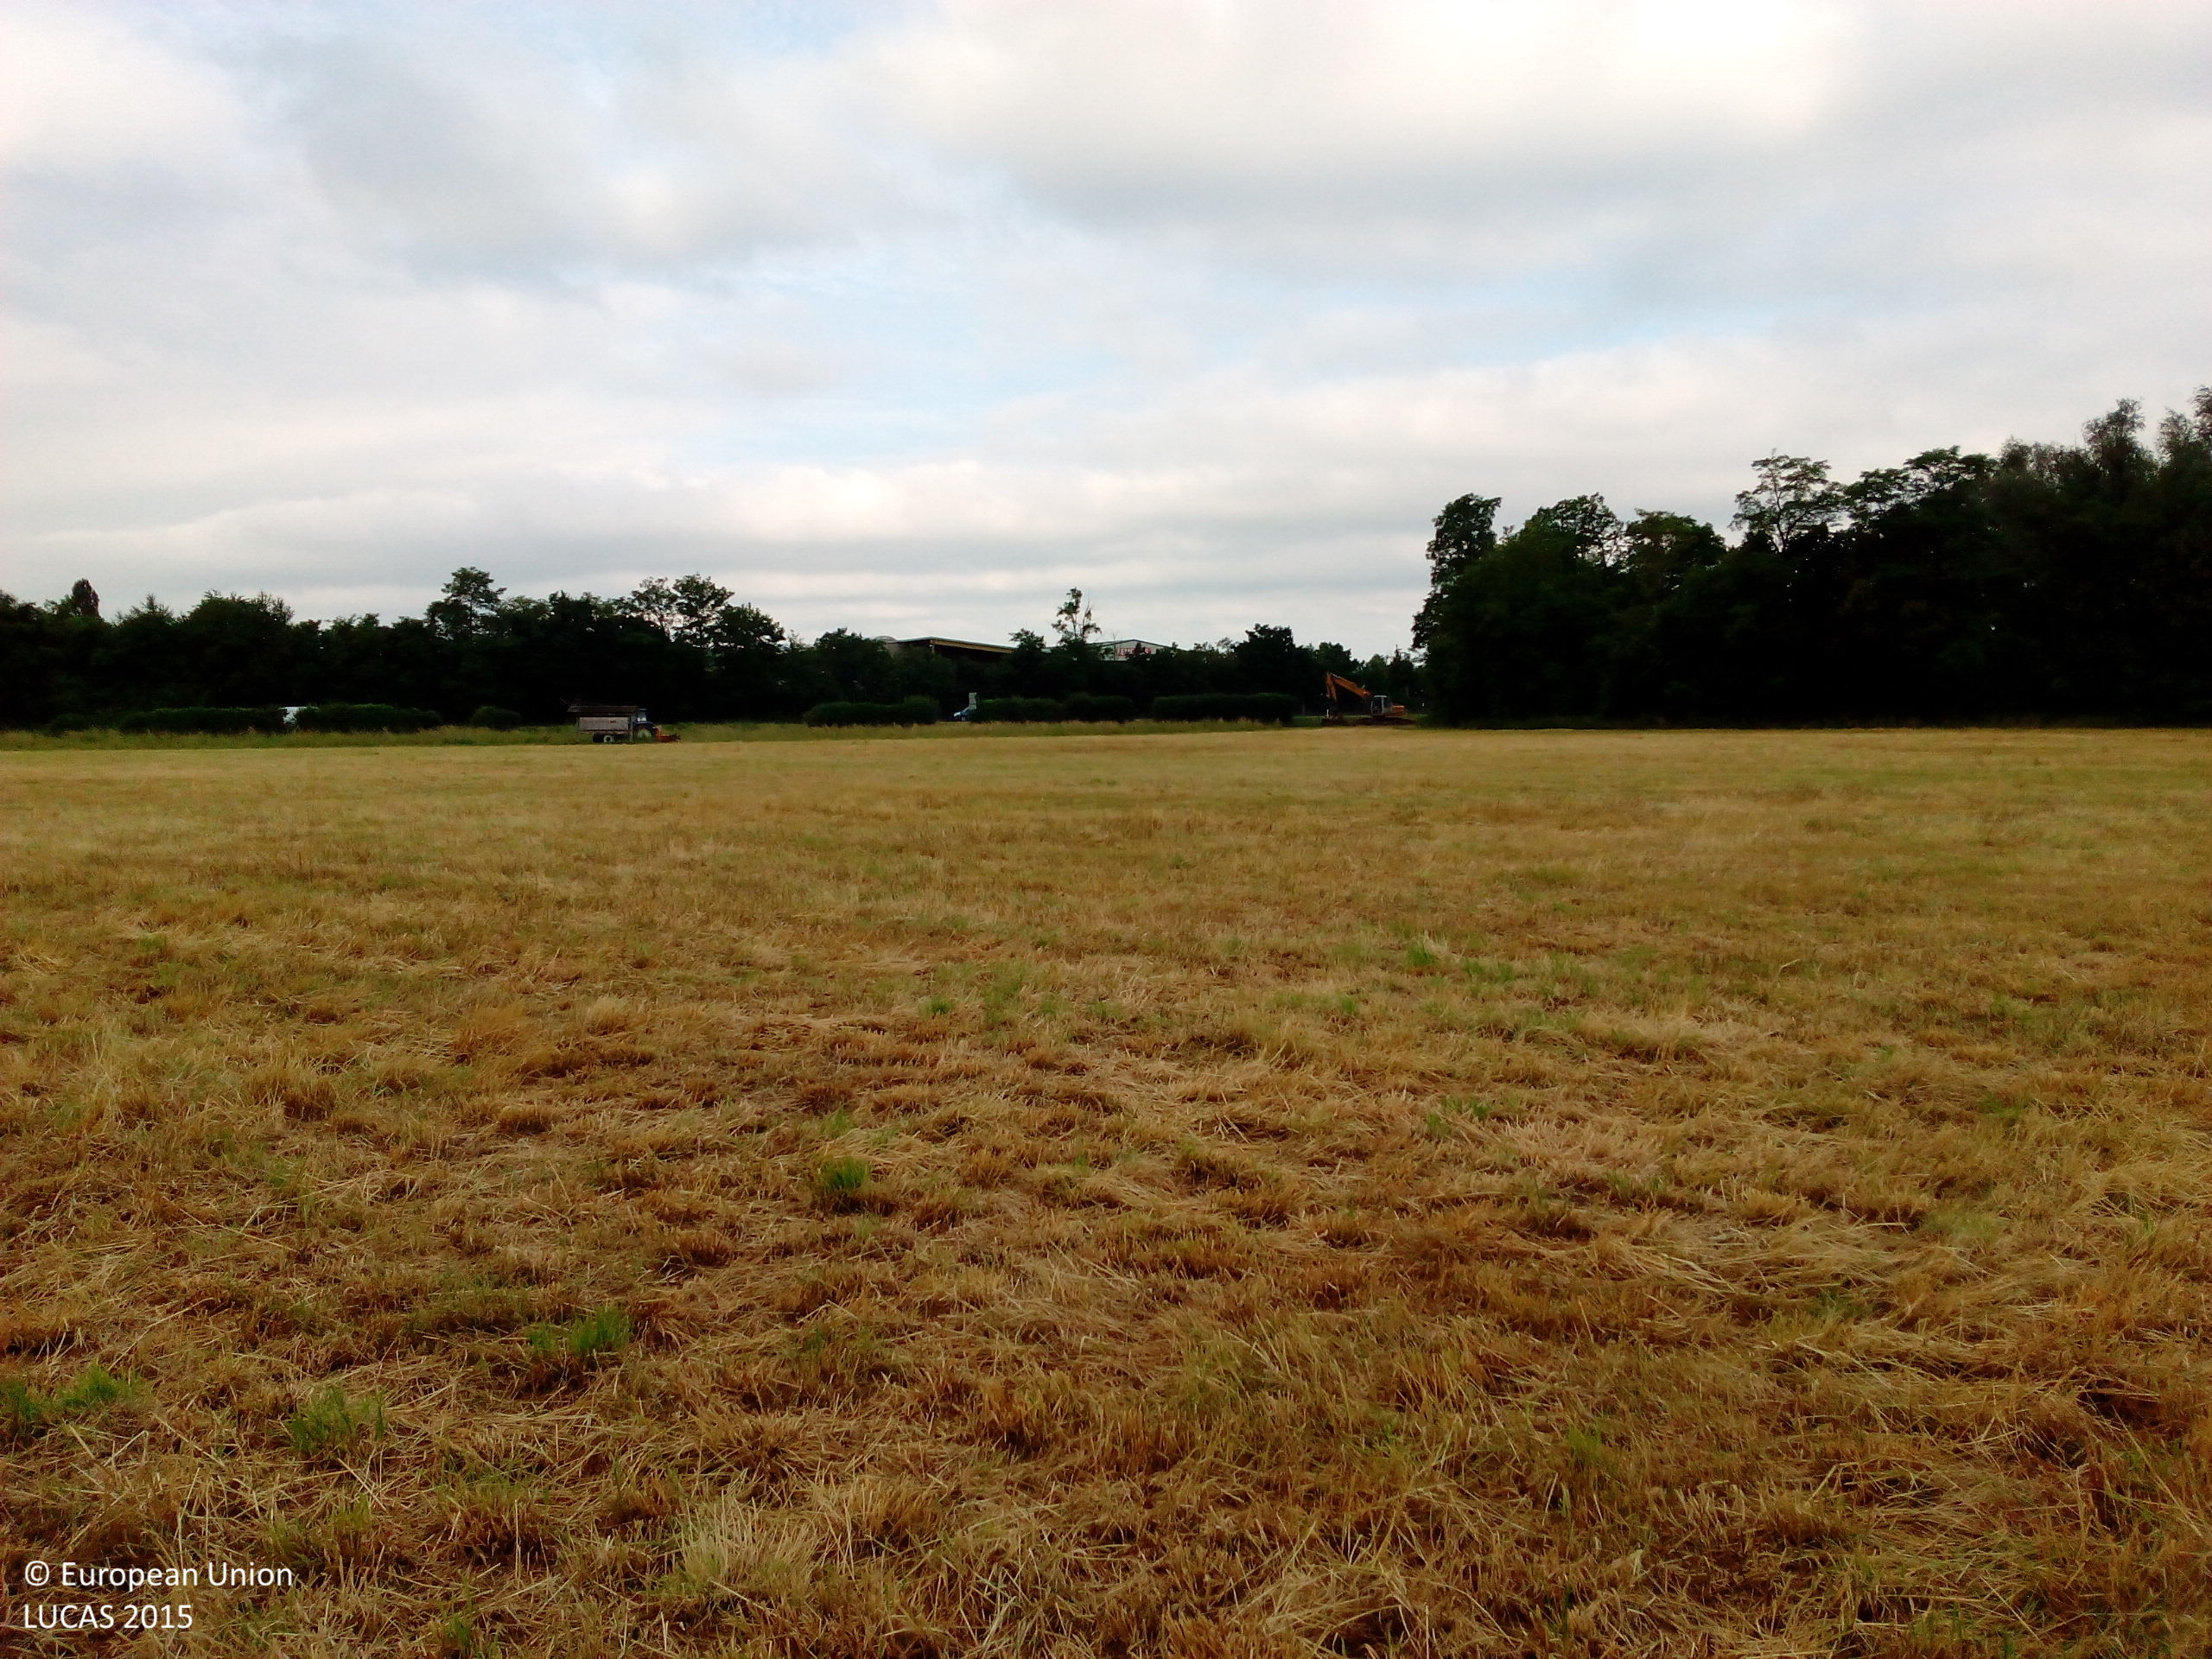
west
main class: Grassland
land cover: Grassland without tree/shrub cover
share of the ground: > 75 %
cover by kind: herbaceous plants 100 %
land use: Agriculture (excluding fallow land and kitchen gardens)
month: June
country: DE
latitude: 48.0000
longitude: 7.6289
